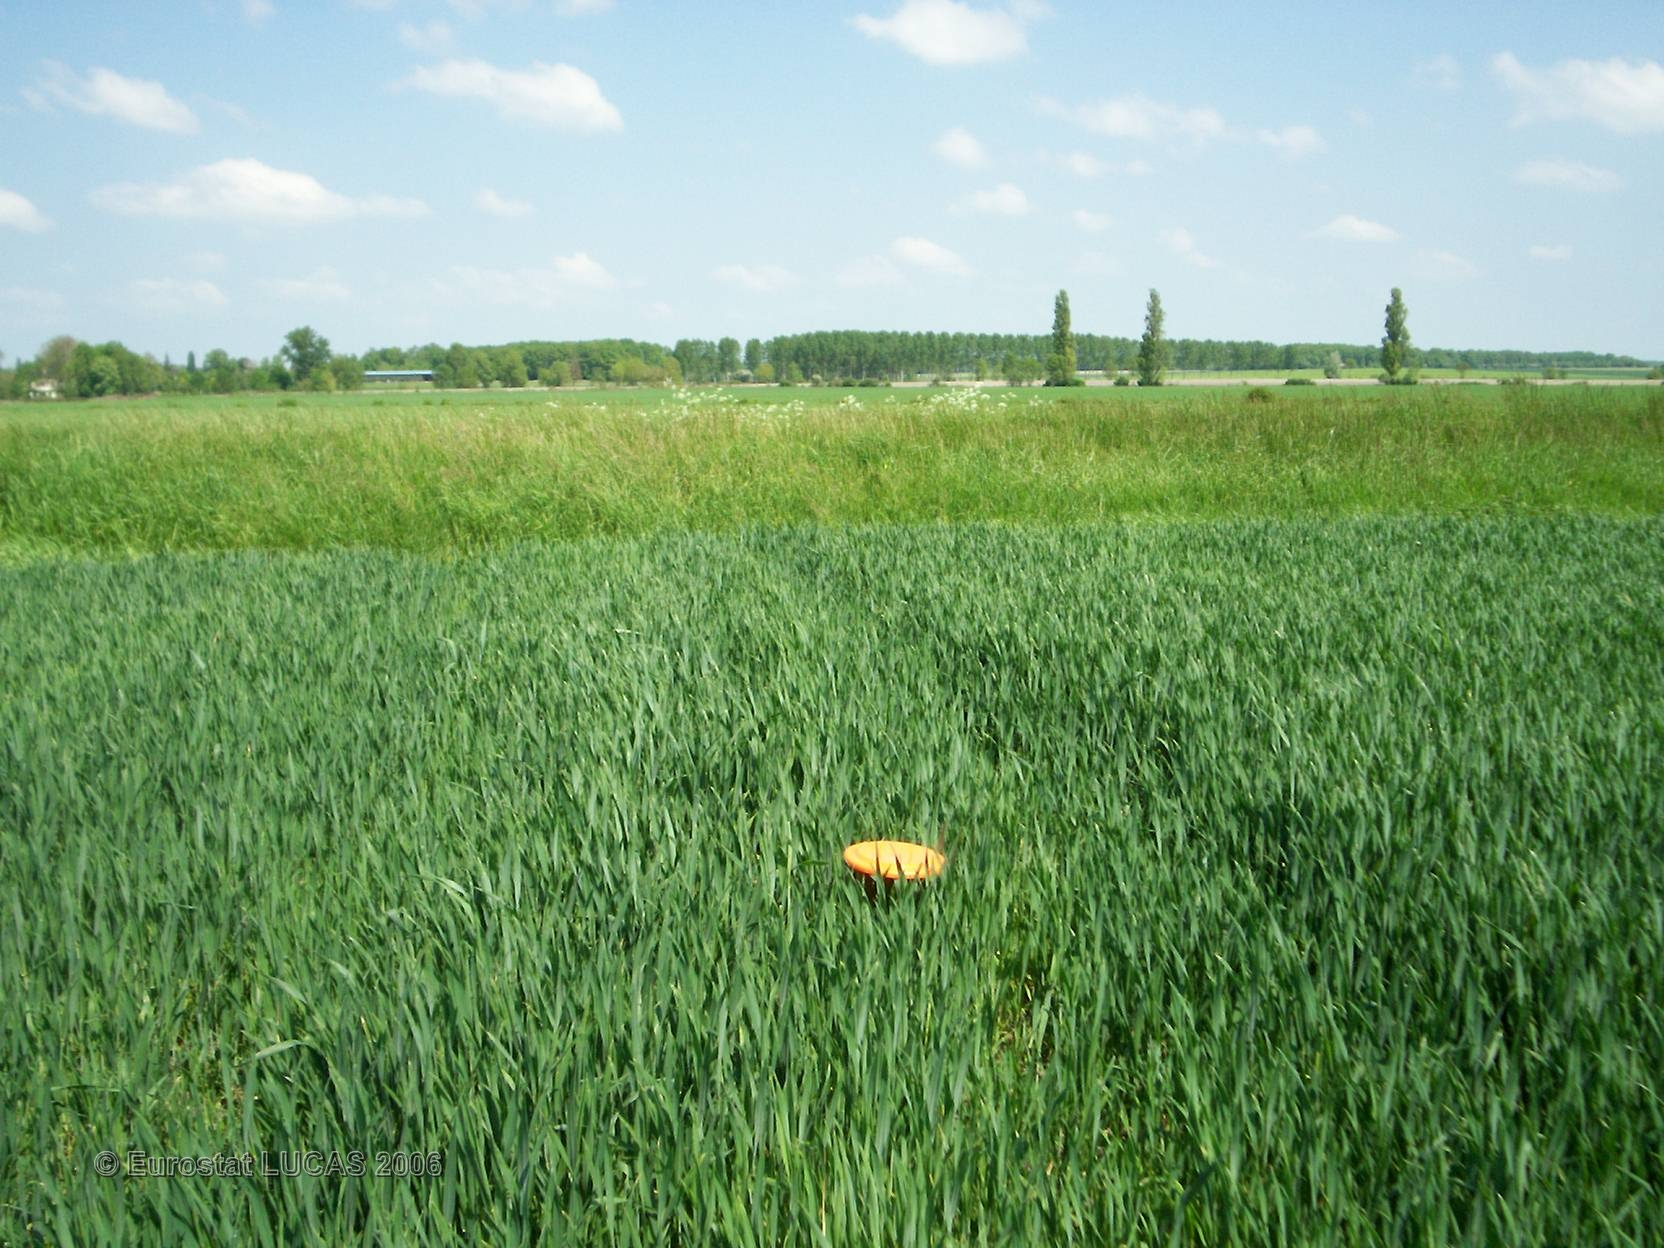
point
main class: Cropland
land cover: Common wheat
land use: Agriculture (excluding fallow land and kitchen gardens)
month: May
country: FR
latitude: 47.4465
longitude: 0.2557
